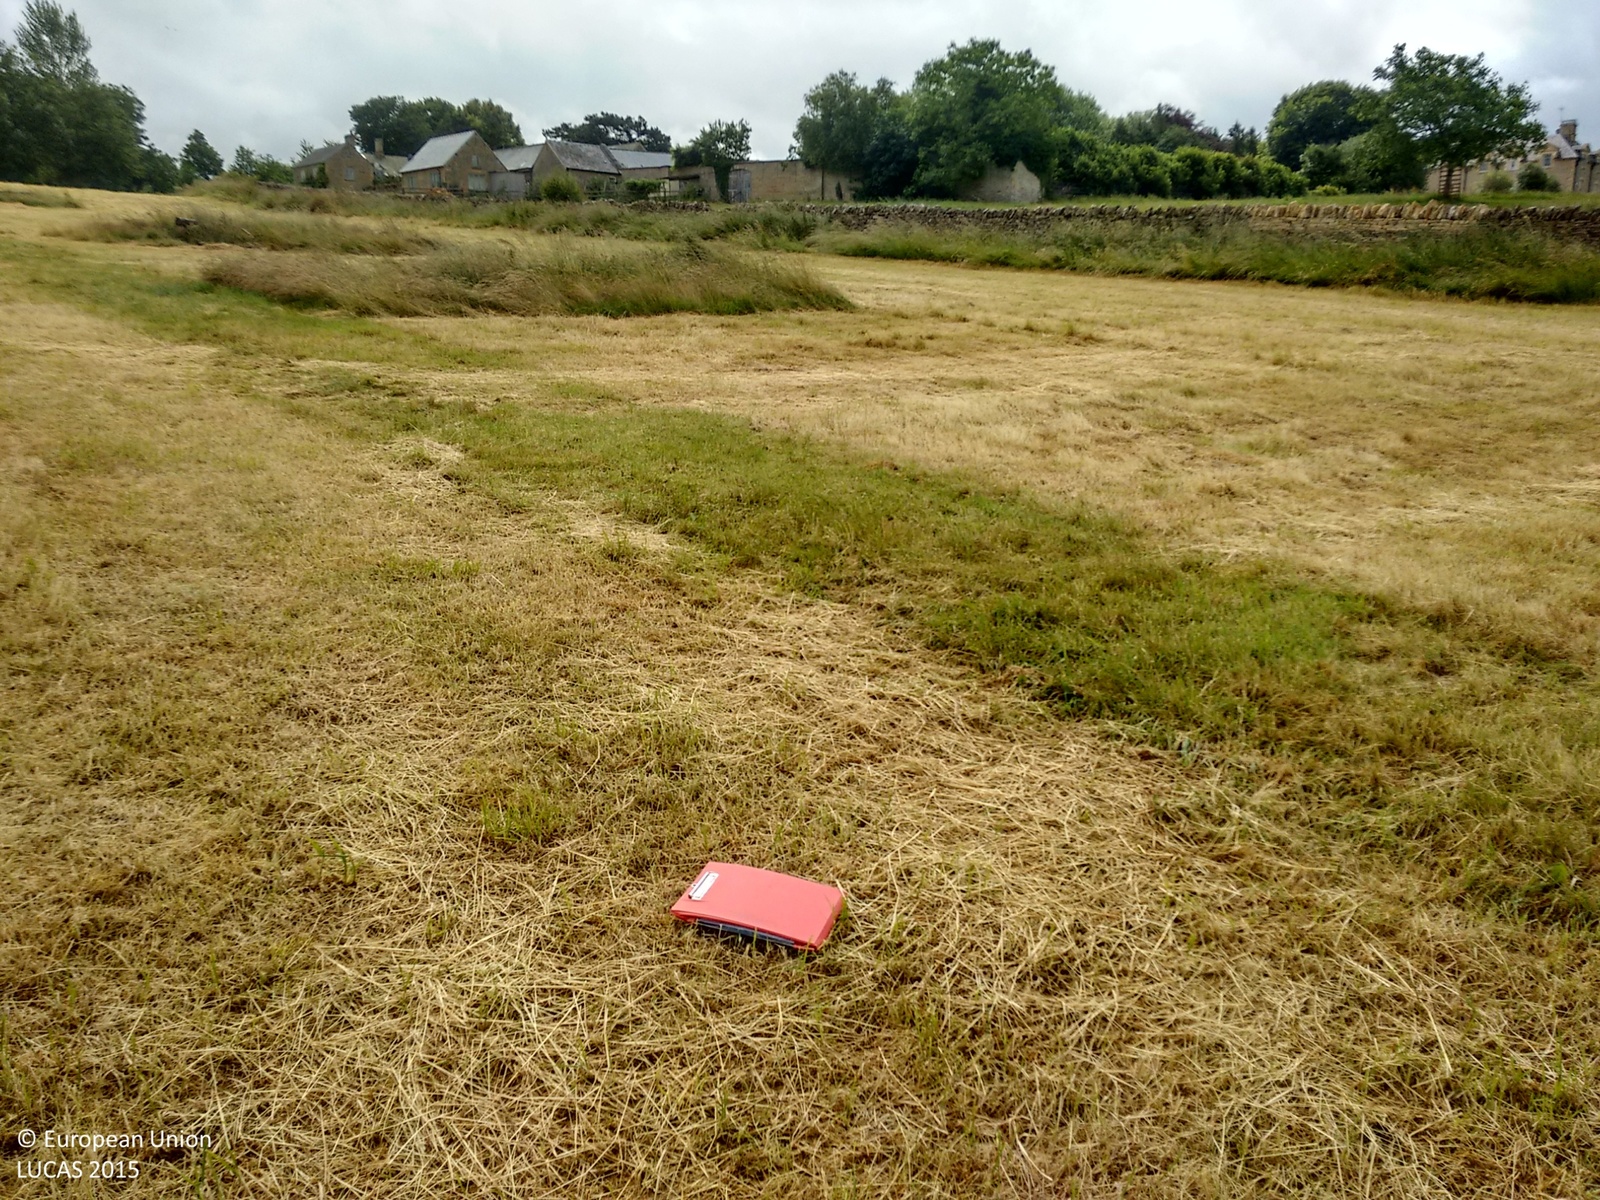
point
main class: Grassland
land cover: Grassland without tree/shrub cover
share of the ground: > 75 %
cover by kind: herbaceous plants 100 %
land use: Residential
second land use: Agriculture (excluding fallow land and kitchen gardens)
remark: Harvested field
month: July
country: GB
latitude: 51.8997
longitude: -1.5771
